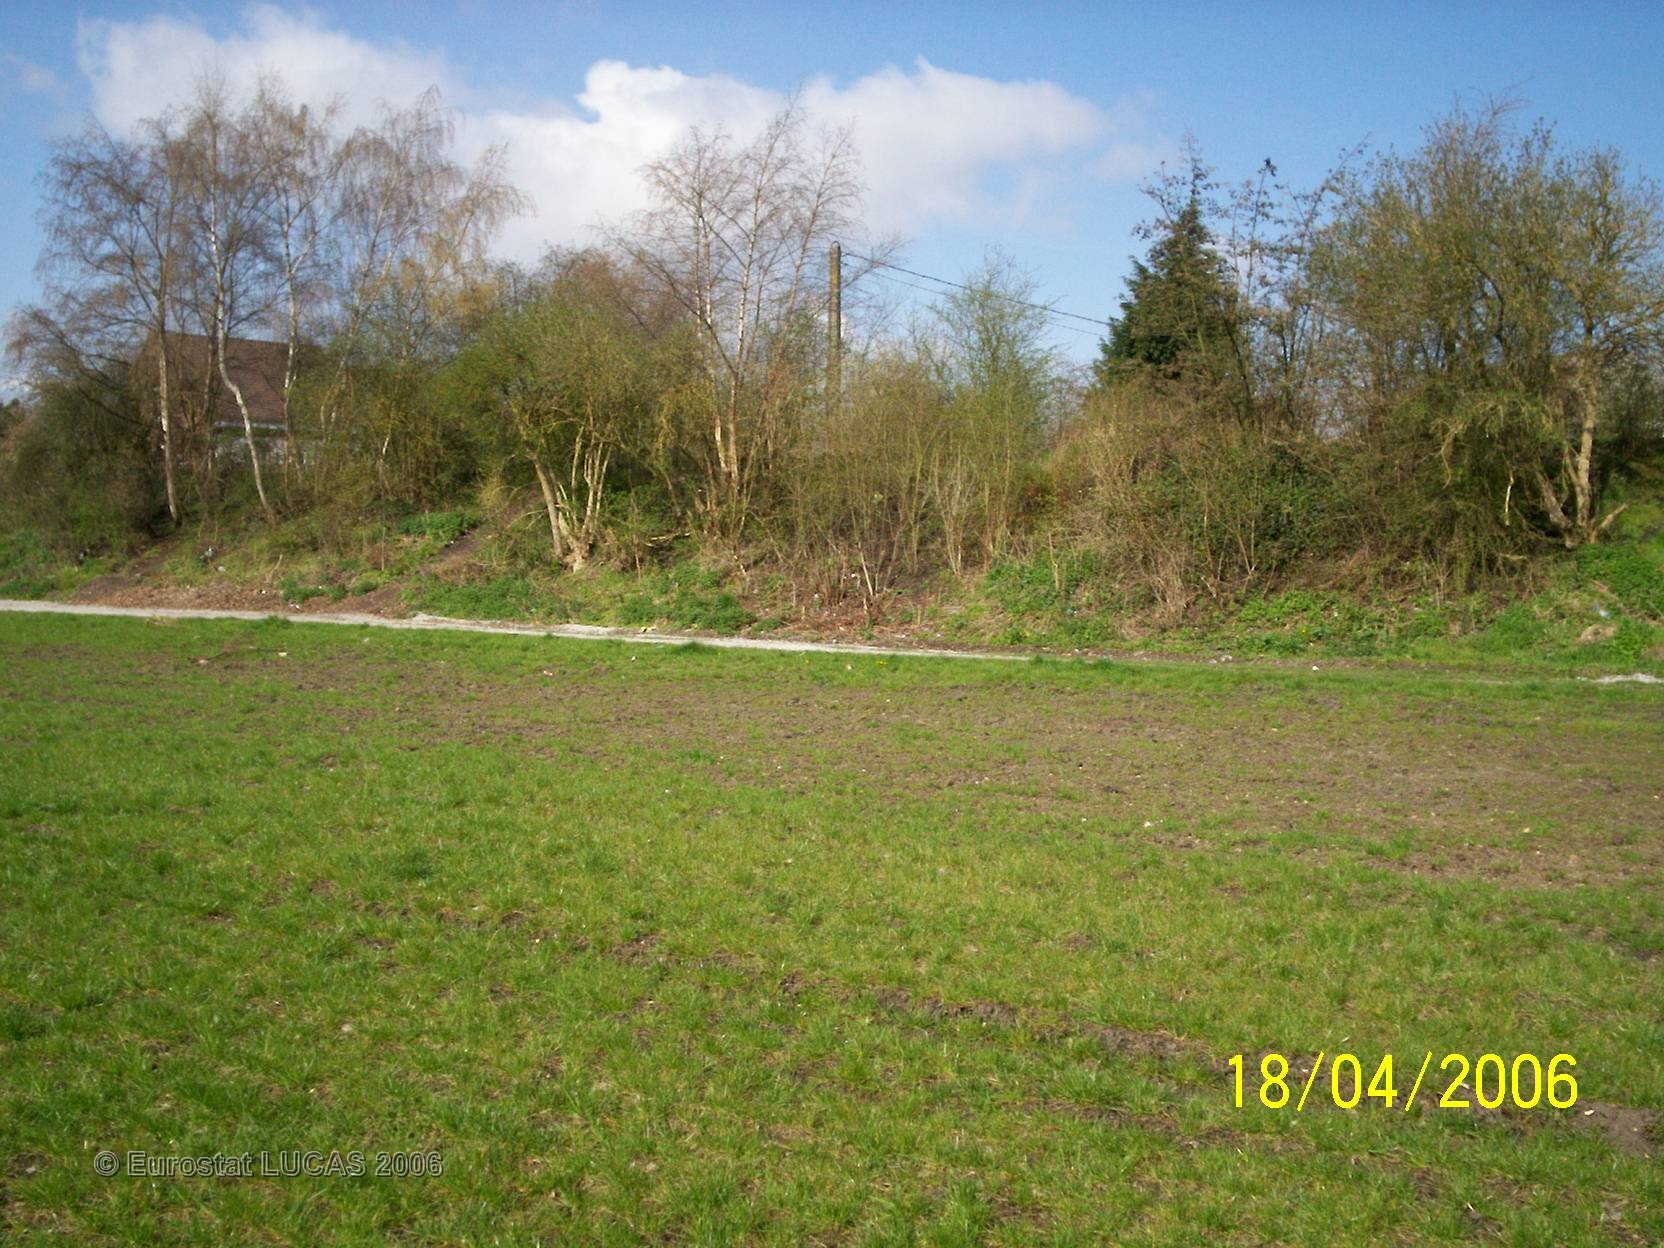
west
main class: Grassland
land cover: Grassland without tree/shrub cover
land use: Agriculture (excluding fallow land and kitchen gardens)
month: April
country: FR
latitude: 50.4507
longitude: 2.6223
